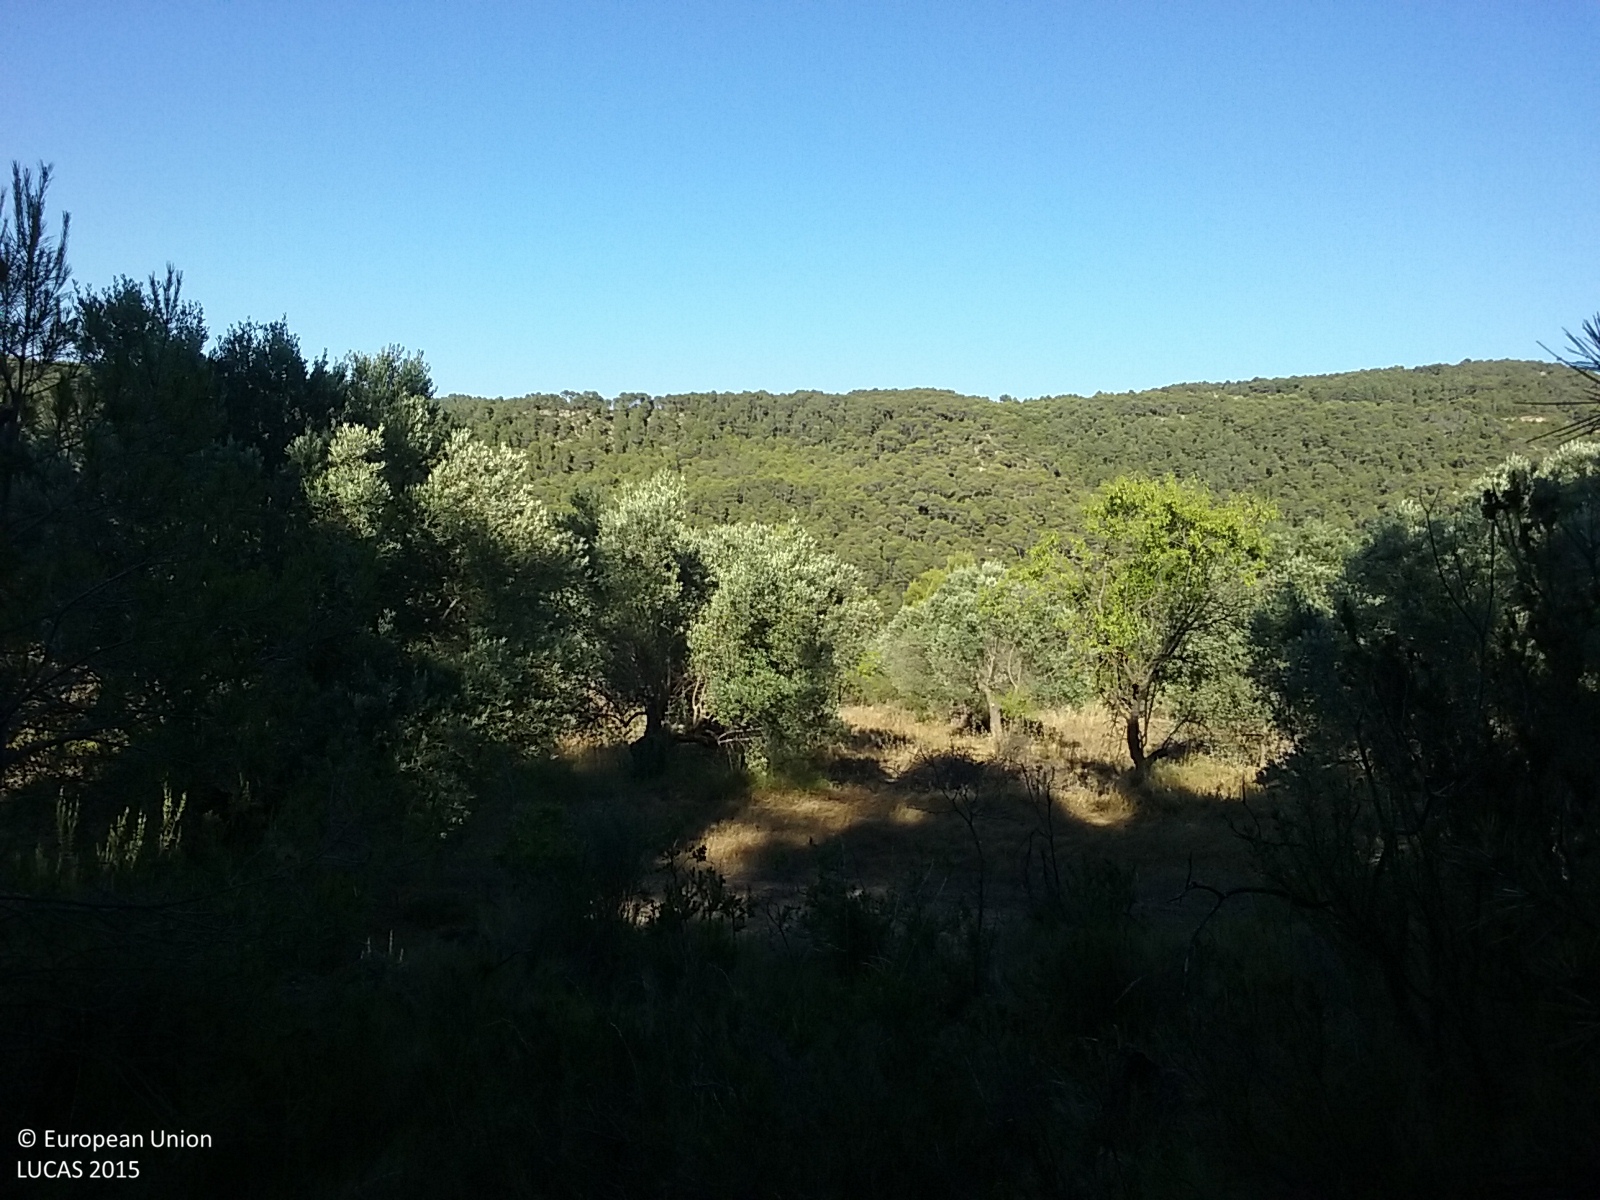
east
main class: Woodland
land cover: Pine dominated coniferous woodland
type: coniferous forest of the mediterranean region
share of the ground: 25 - 50 %
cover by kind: shrubs 75 %, coniferous forest trees 25 %
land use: Semi-natural and natural areas not in use
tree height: > 5 m
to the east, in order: Pine dominated coniferous woodland; Olive groves; Dry stone walls; Olive groves; Dry stone walls; Olive groves; Dry stone walls; Olive groves; Dry stone walls; Olive groves; Dry stone walls; Pine dominated coniferous woodland; Tracks; Pine dominated coniferous woodland; Dry stone walls; Pine dominated coniferous woodland
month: June
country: ES
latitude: 40.9985
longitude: 0.2307
